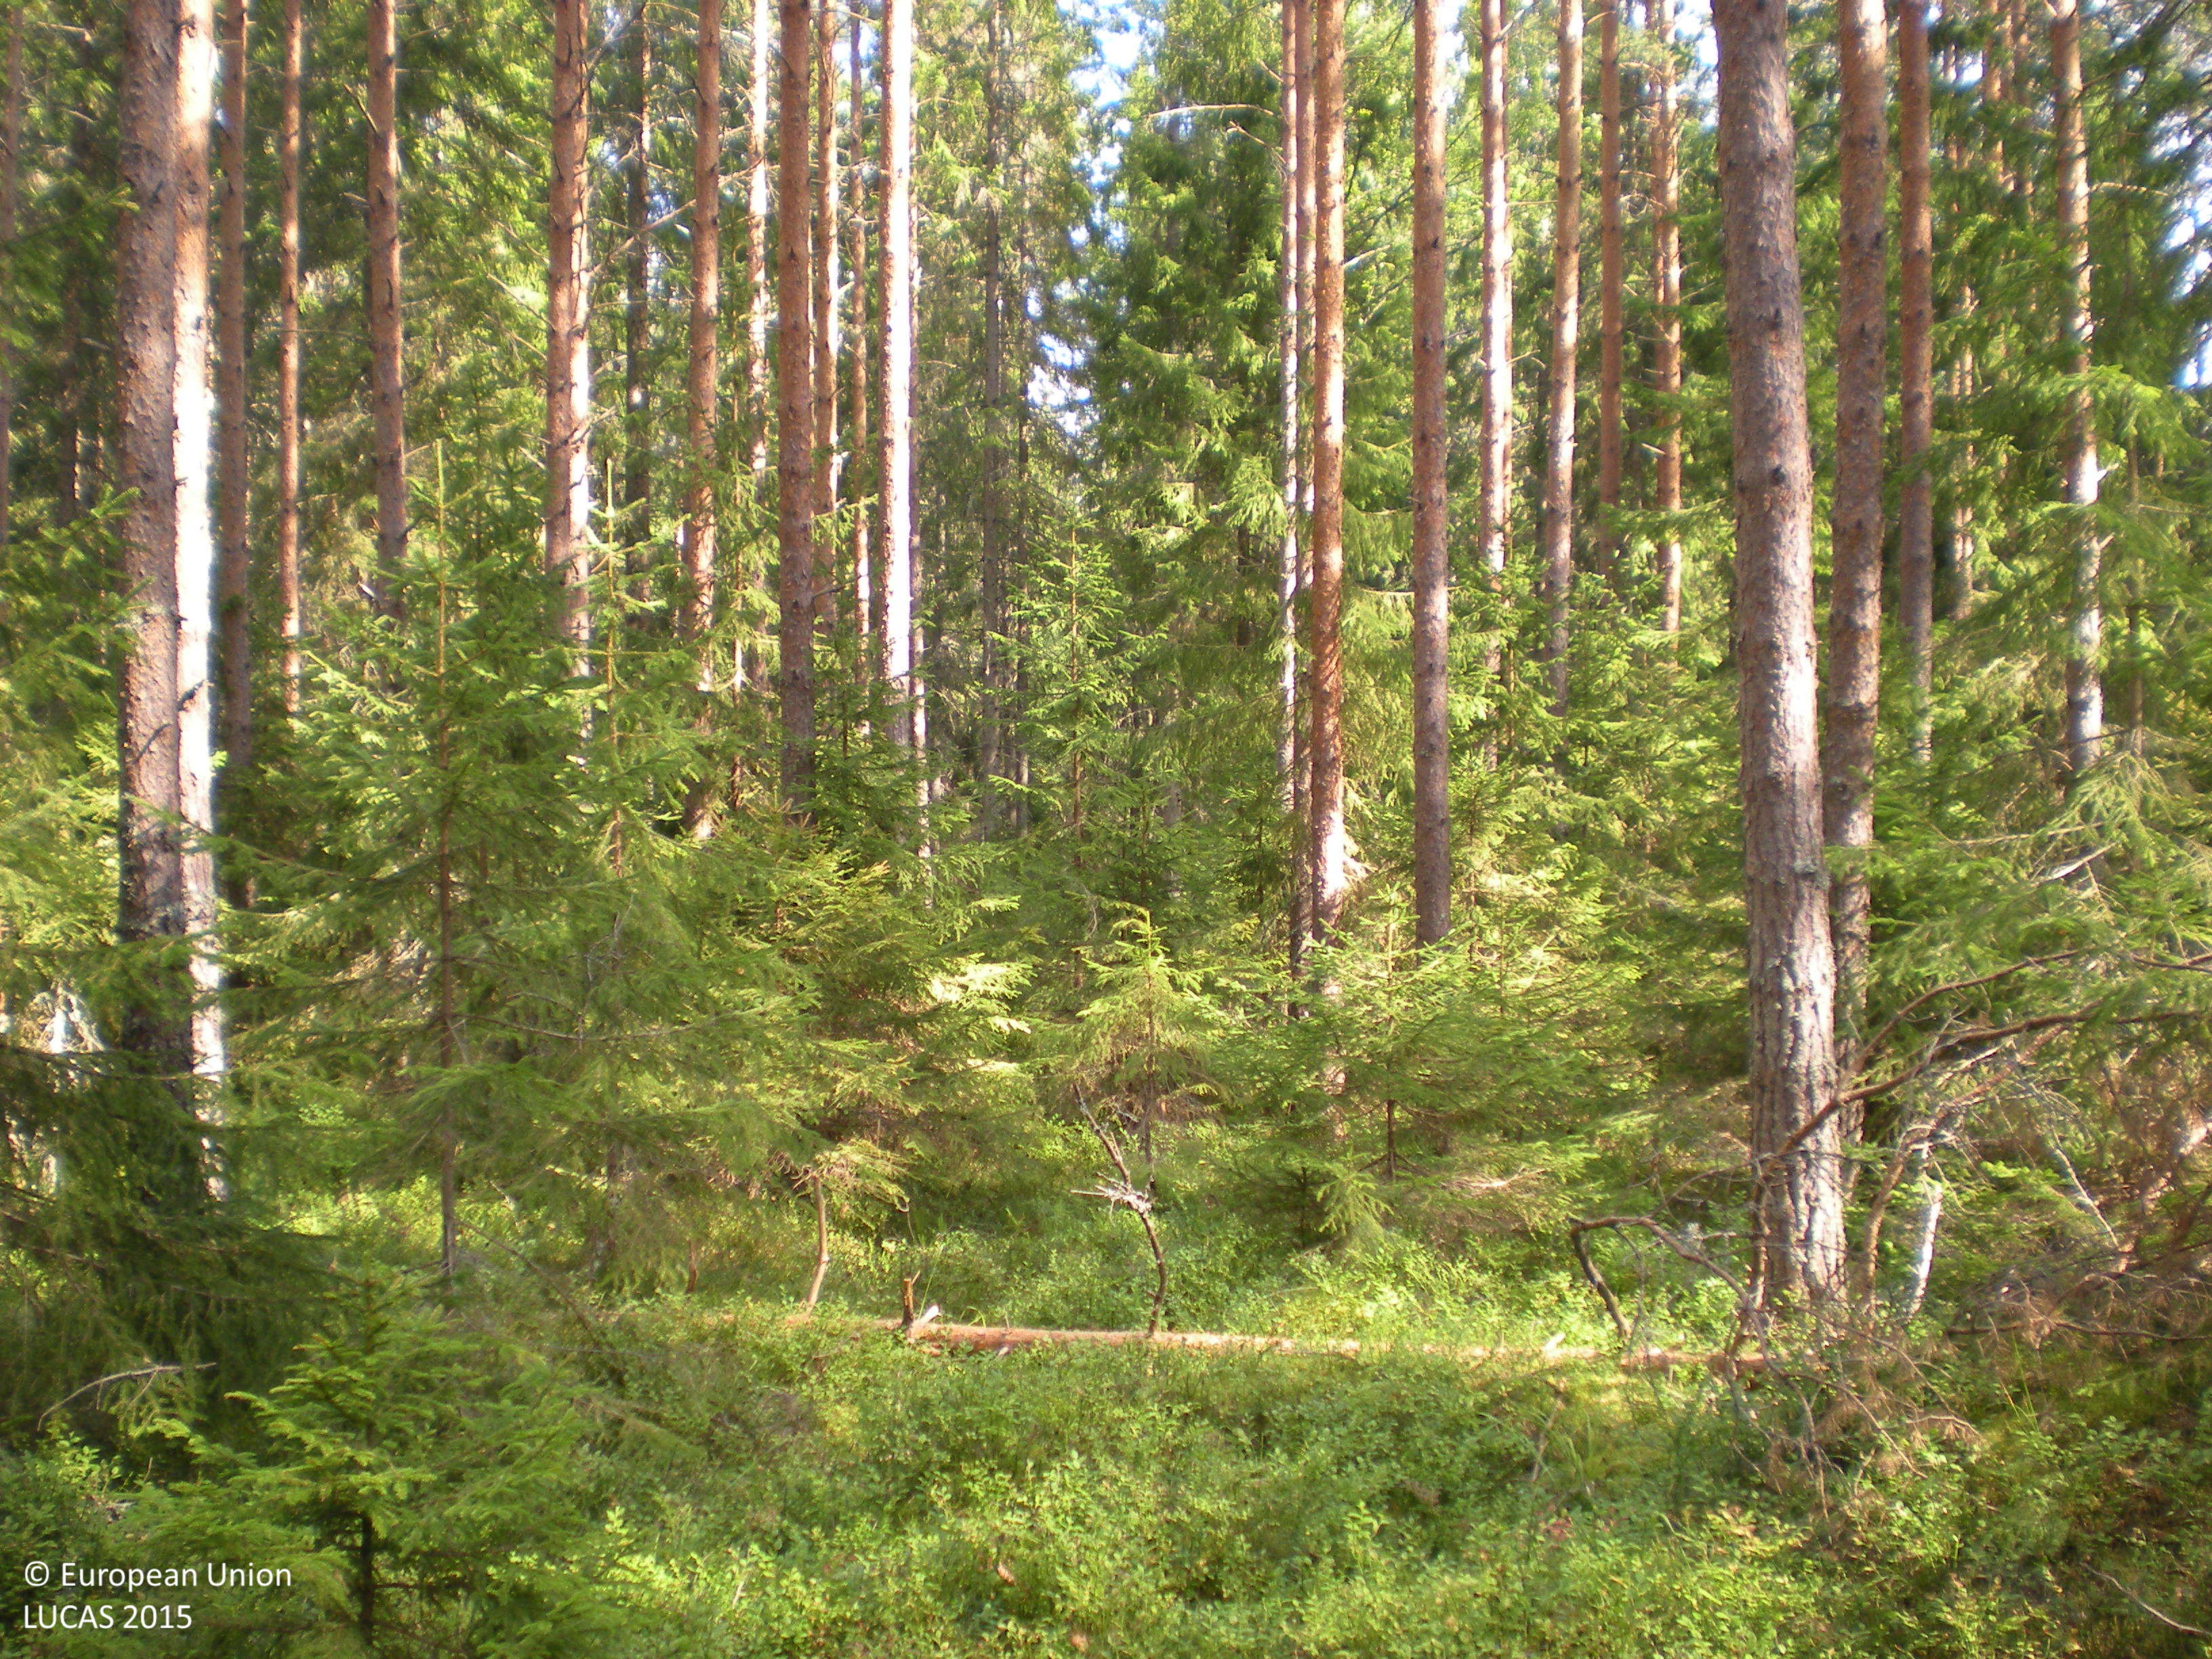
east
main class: Woodland
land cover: Pine dominated coniferous woodland
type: boreal forest
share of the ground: 50 - 75 %
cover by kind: coniferous forest trees 70 %, shrubs 25 %, lichens and mosses 5 %
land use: Forestry
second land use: Amenities, museums, leisure
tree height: > 5 m
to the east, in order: Pine dominated coniferous woodland; Other coniferous woodland; Spruce dominated coniferous woodland; Other coniferous woodland
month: August
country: SE
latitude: 60.4164
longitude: 17.1266
